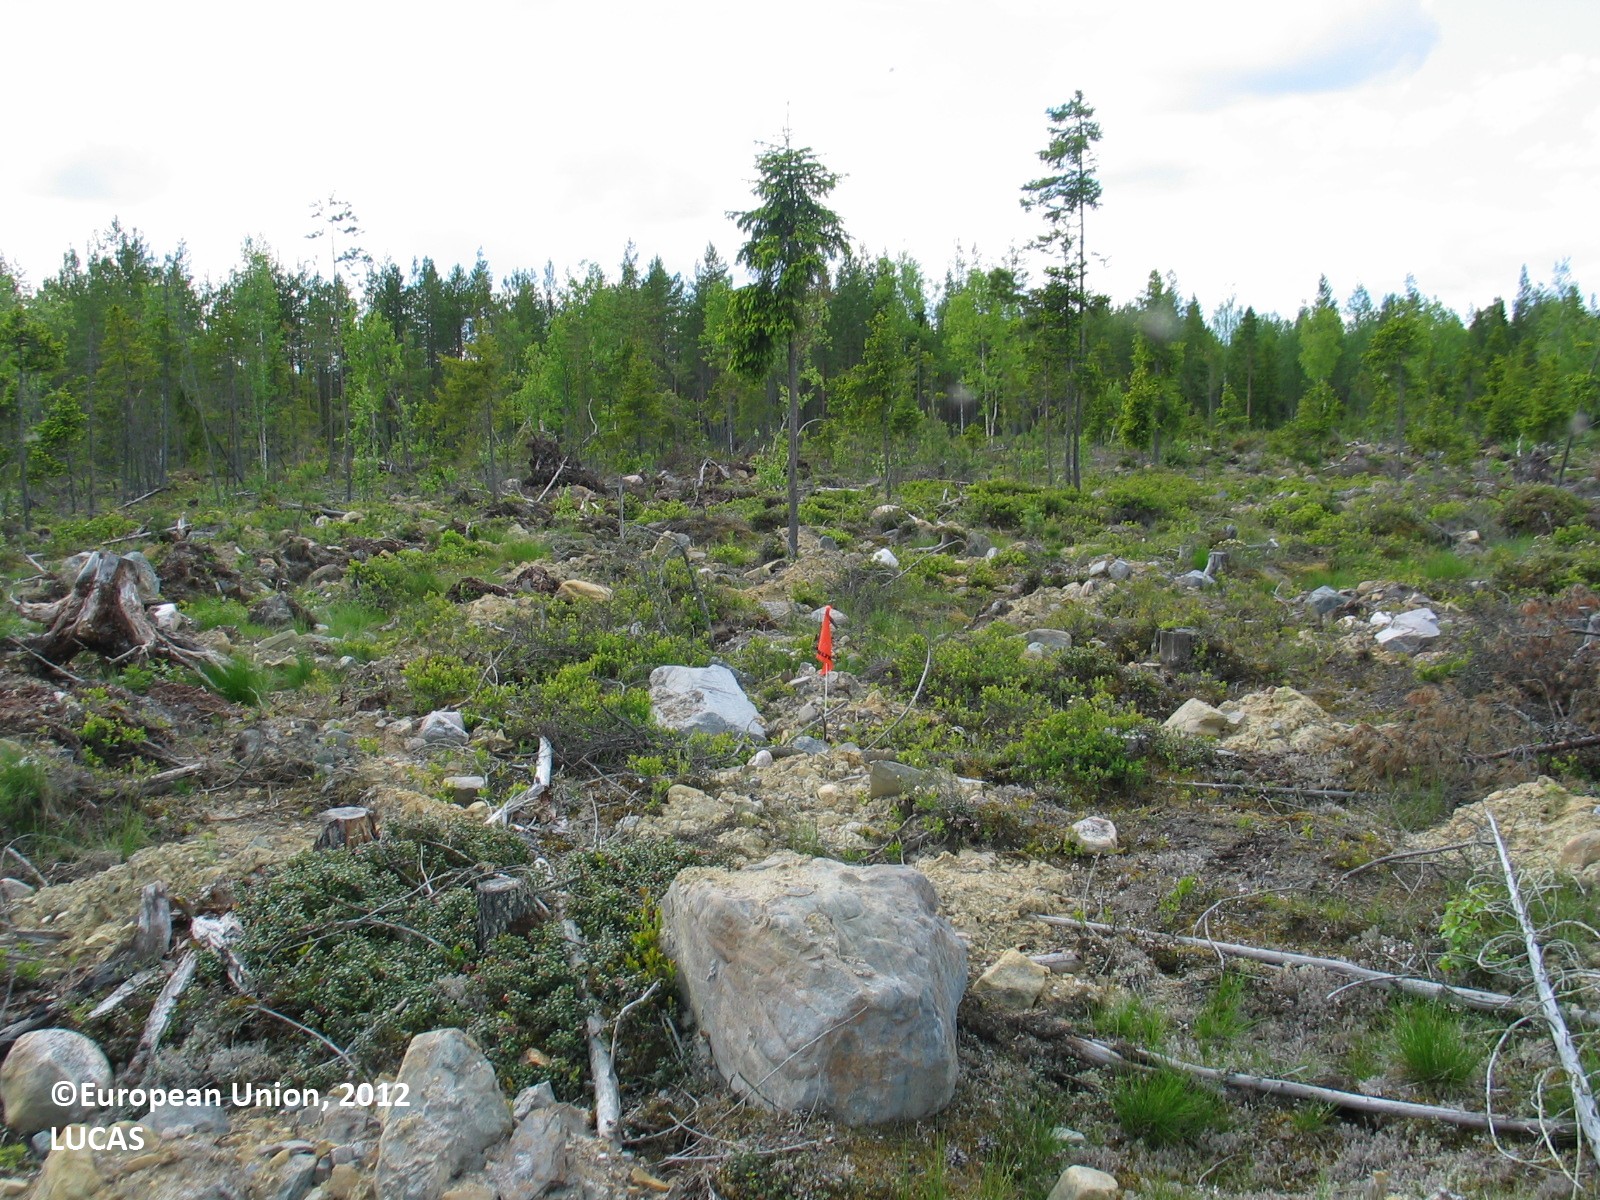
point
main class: Shrubland
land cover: Shrubland without tree cover
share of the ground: 25 - 50 %
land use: Forestry
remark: Clear cut
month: June
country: FI
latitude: 64.8955
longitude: 26.5236
